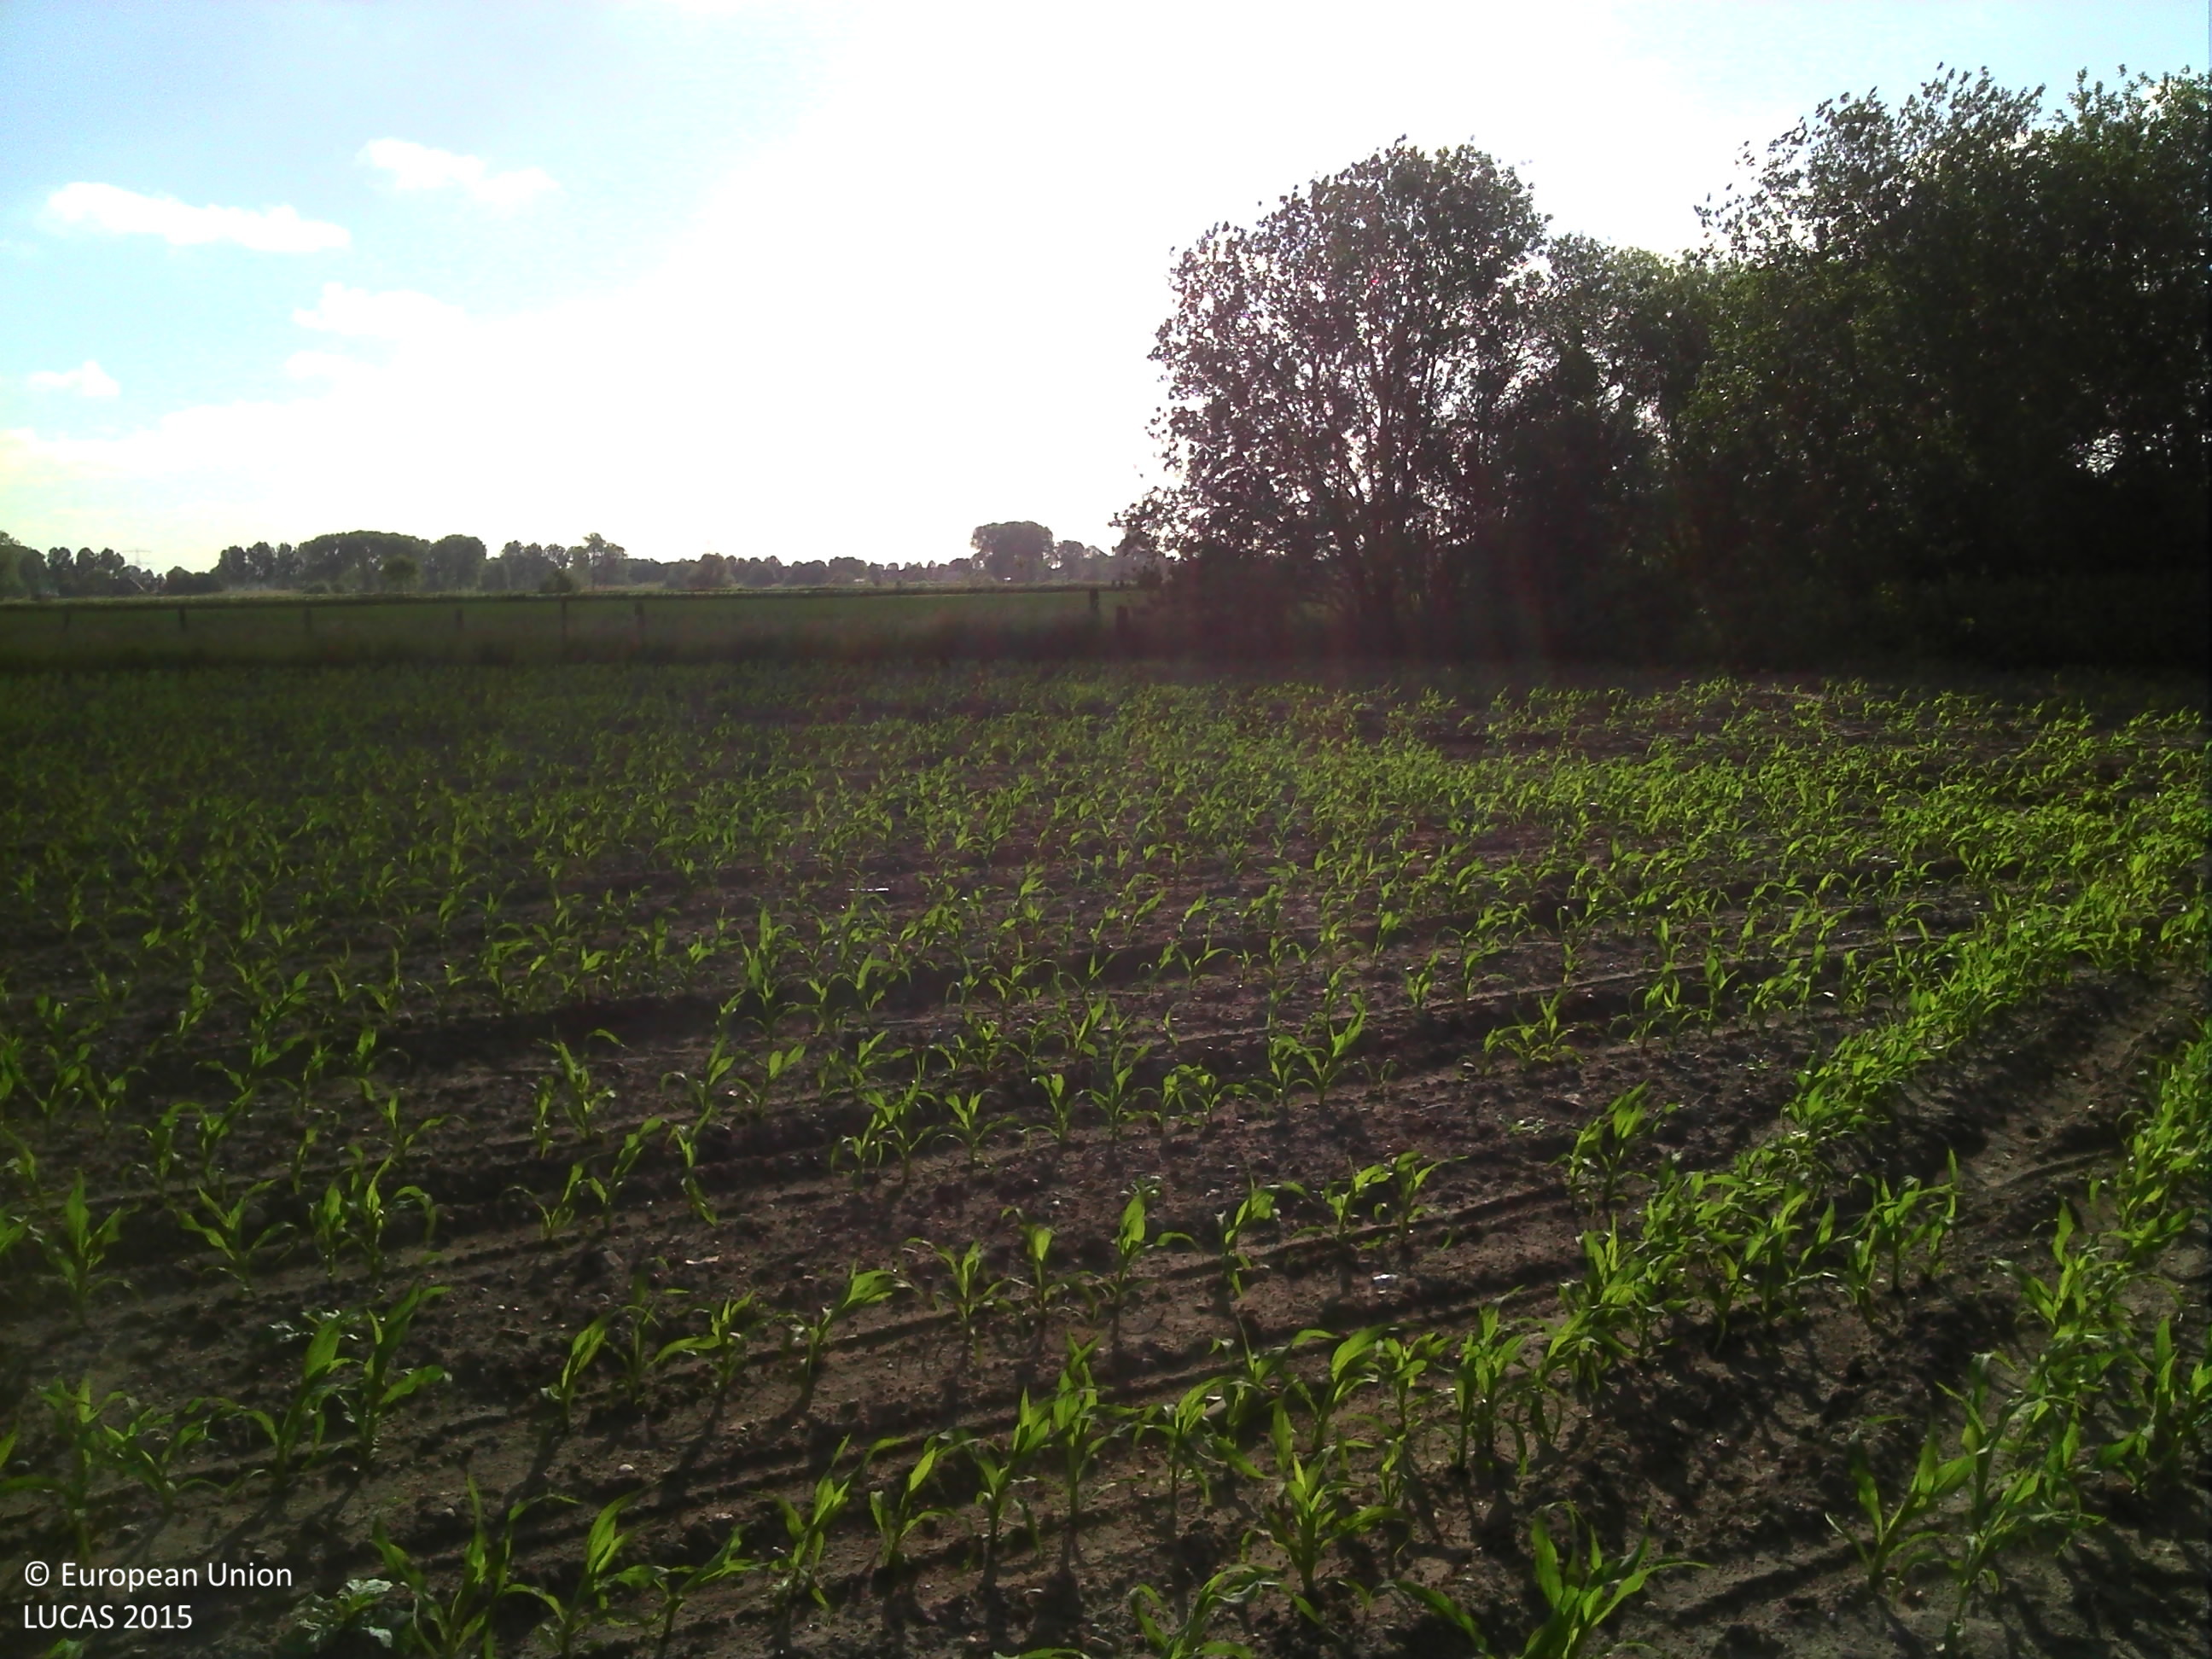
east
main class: Cropland
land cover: Maize
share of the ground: 10 - 25 %
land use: Agriculture (excluding fallow land and kitchen gardens)
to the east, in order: Maize; Grass margins; Abandoned hedges; Grass margins; Maize
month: June
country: BE
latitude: 51.0608
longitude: 5.7895
